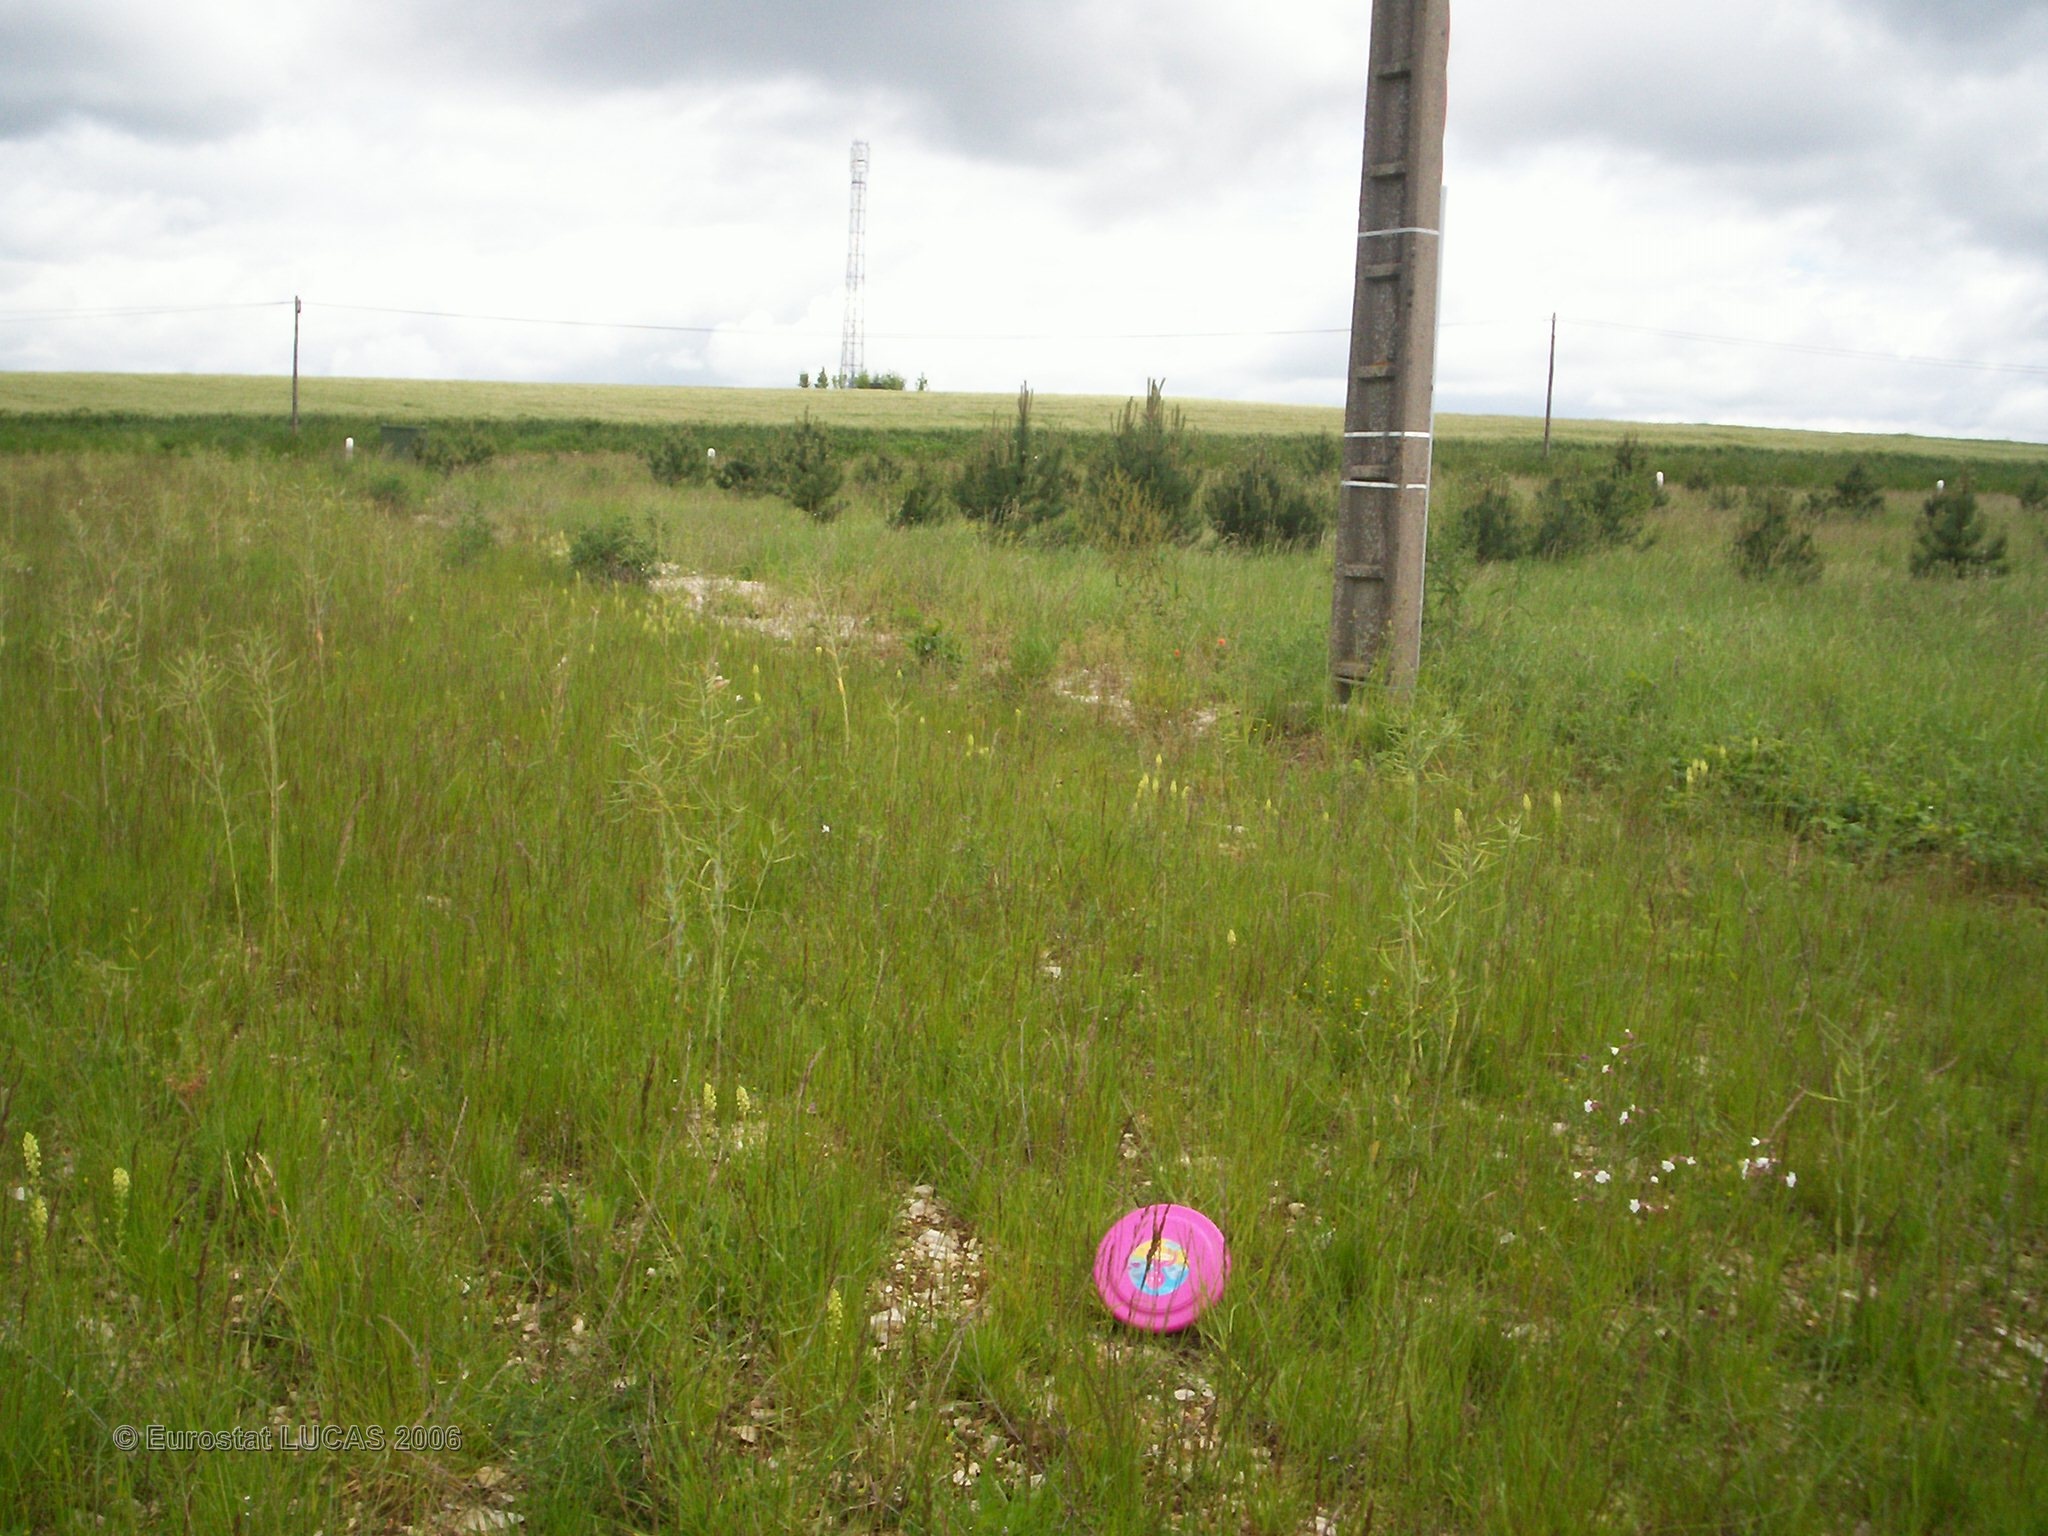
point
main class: Grassland
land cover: Grassland without tree/shrub cover
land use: Agriculture (excluding fallow land and kitchen gardens)
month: May
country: FR
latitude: 47.6015
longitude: 3.8655
